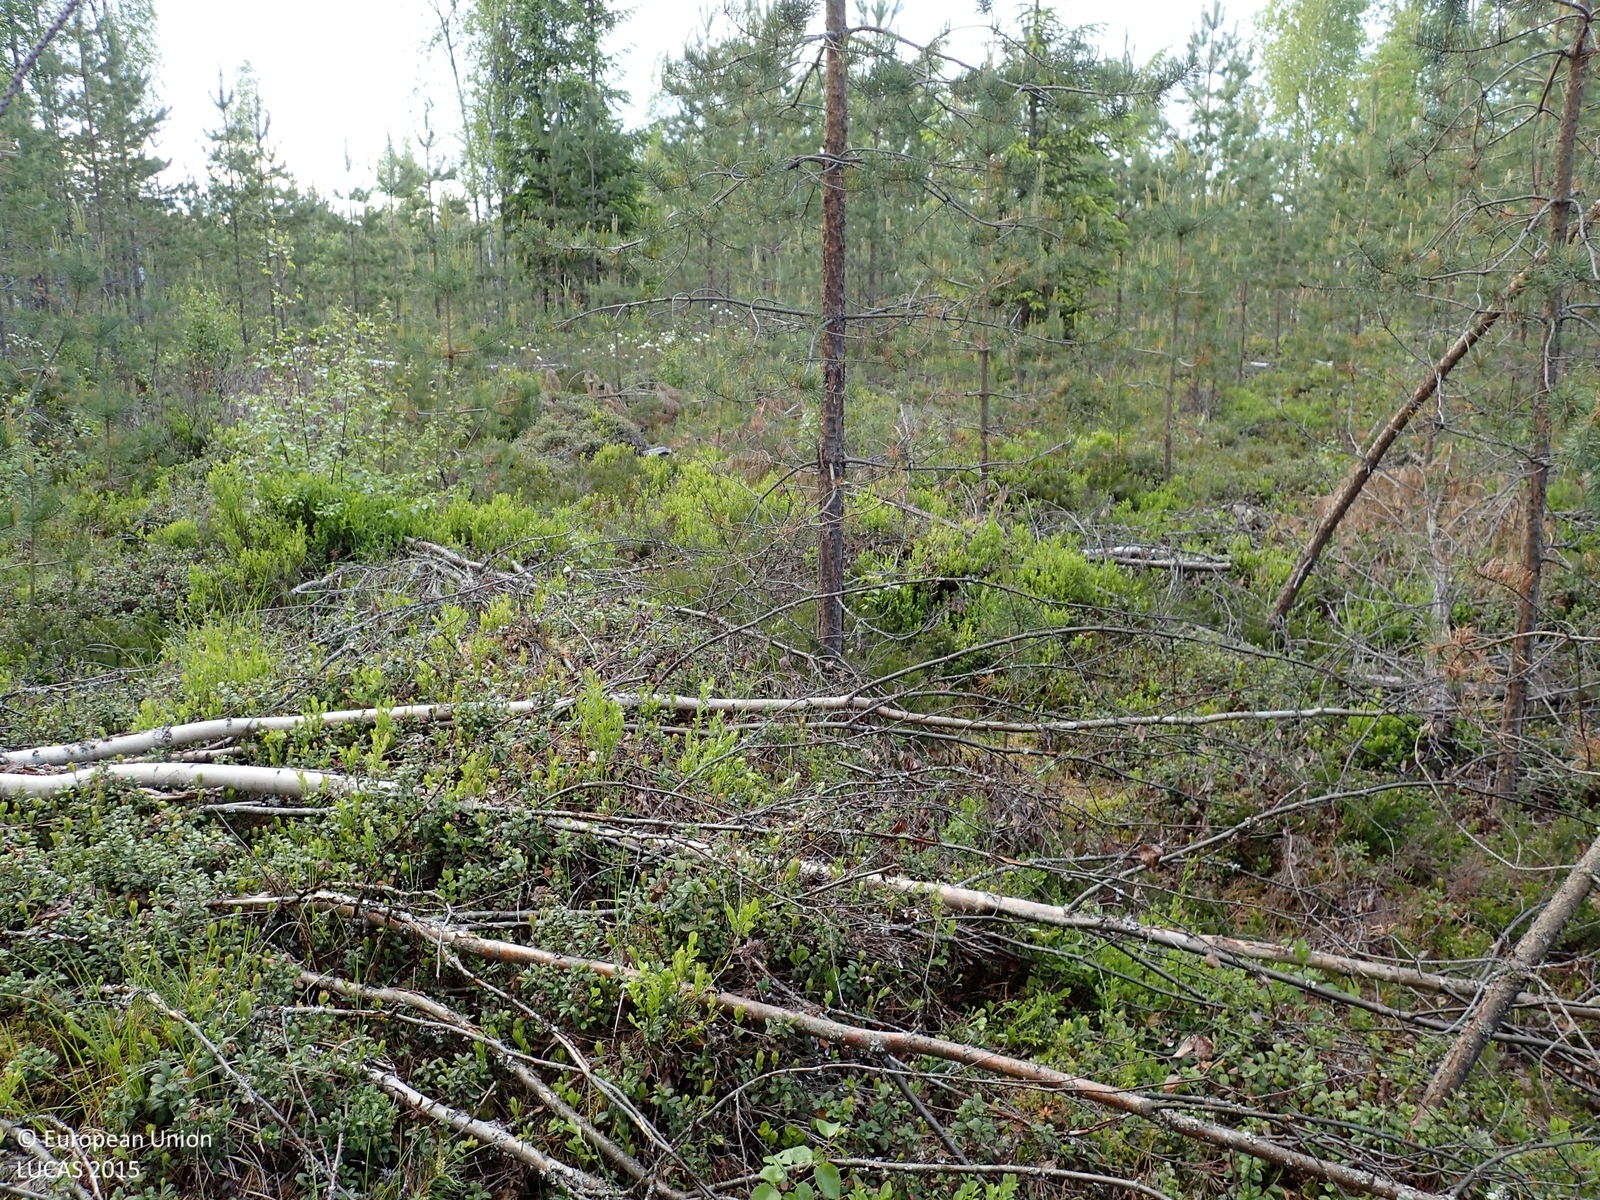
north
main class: Woodland
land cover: Pine dominated mixed woodland
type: boreal forest
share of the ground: 50 - 75 %
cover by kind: shrubs 50 %, coniferous forest trees 35 %, broadleaved forest trees 15 %
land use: Forestry
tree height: < 5 m
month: June
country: FI
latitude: 62.5104
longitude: 23.1342
